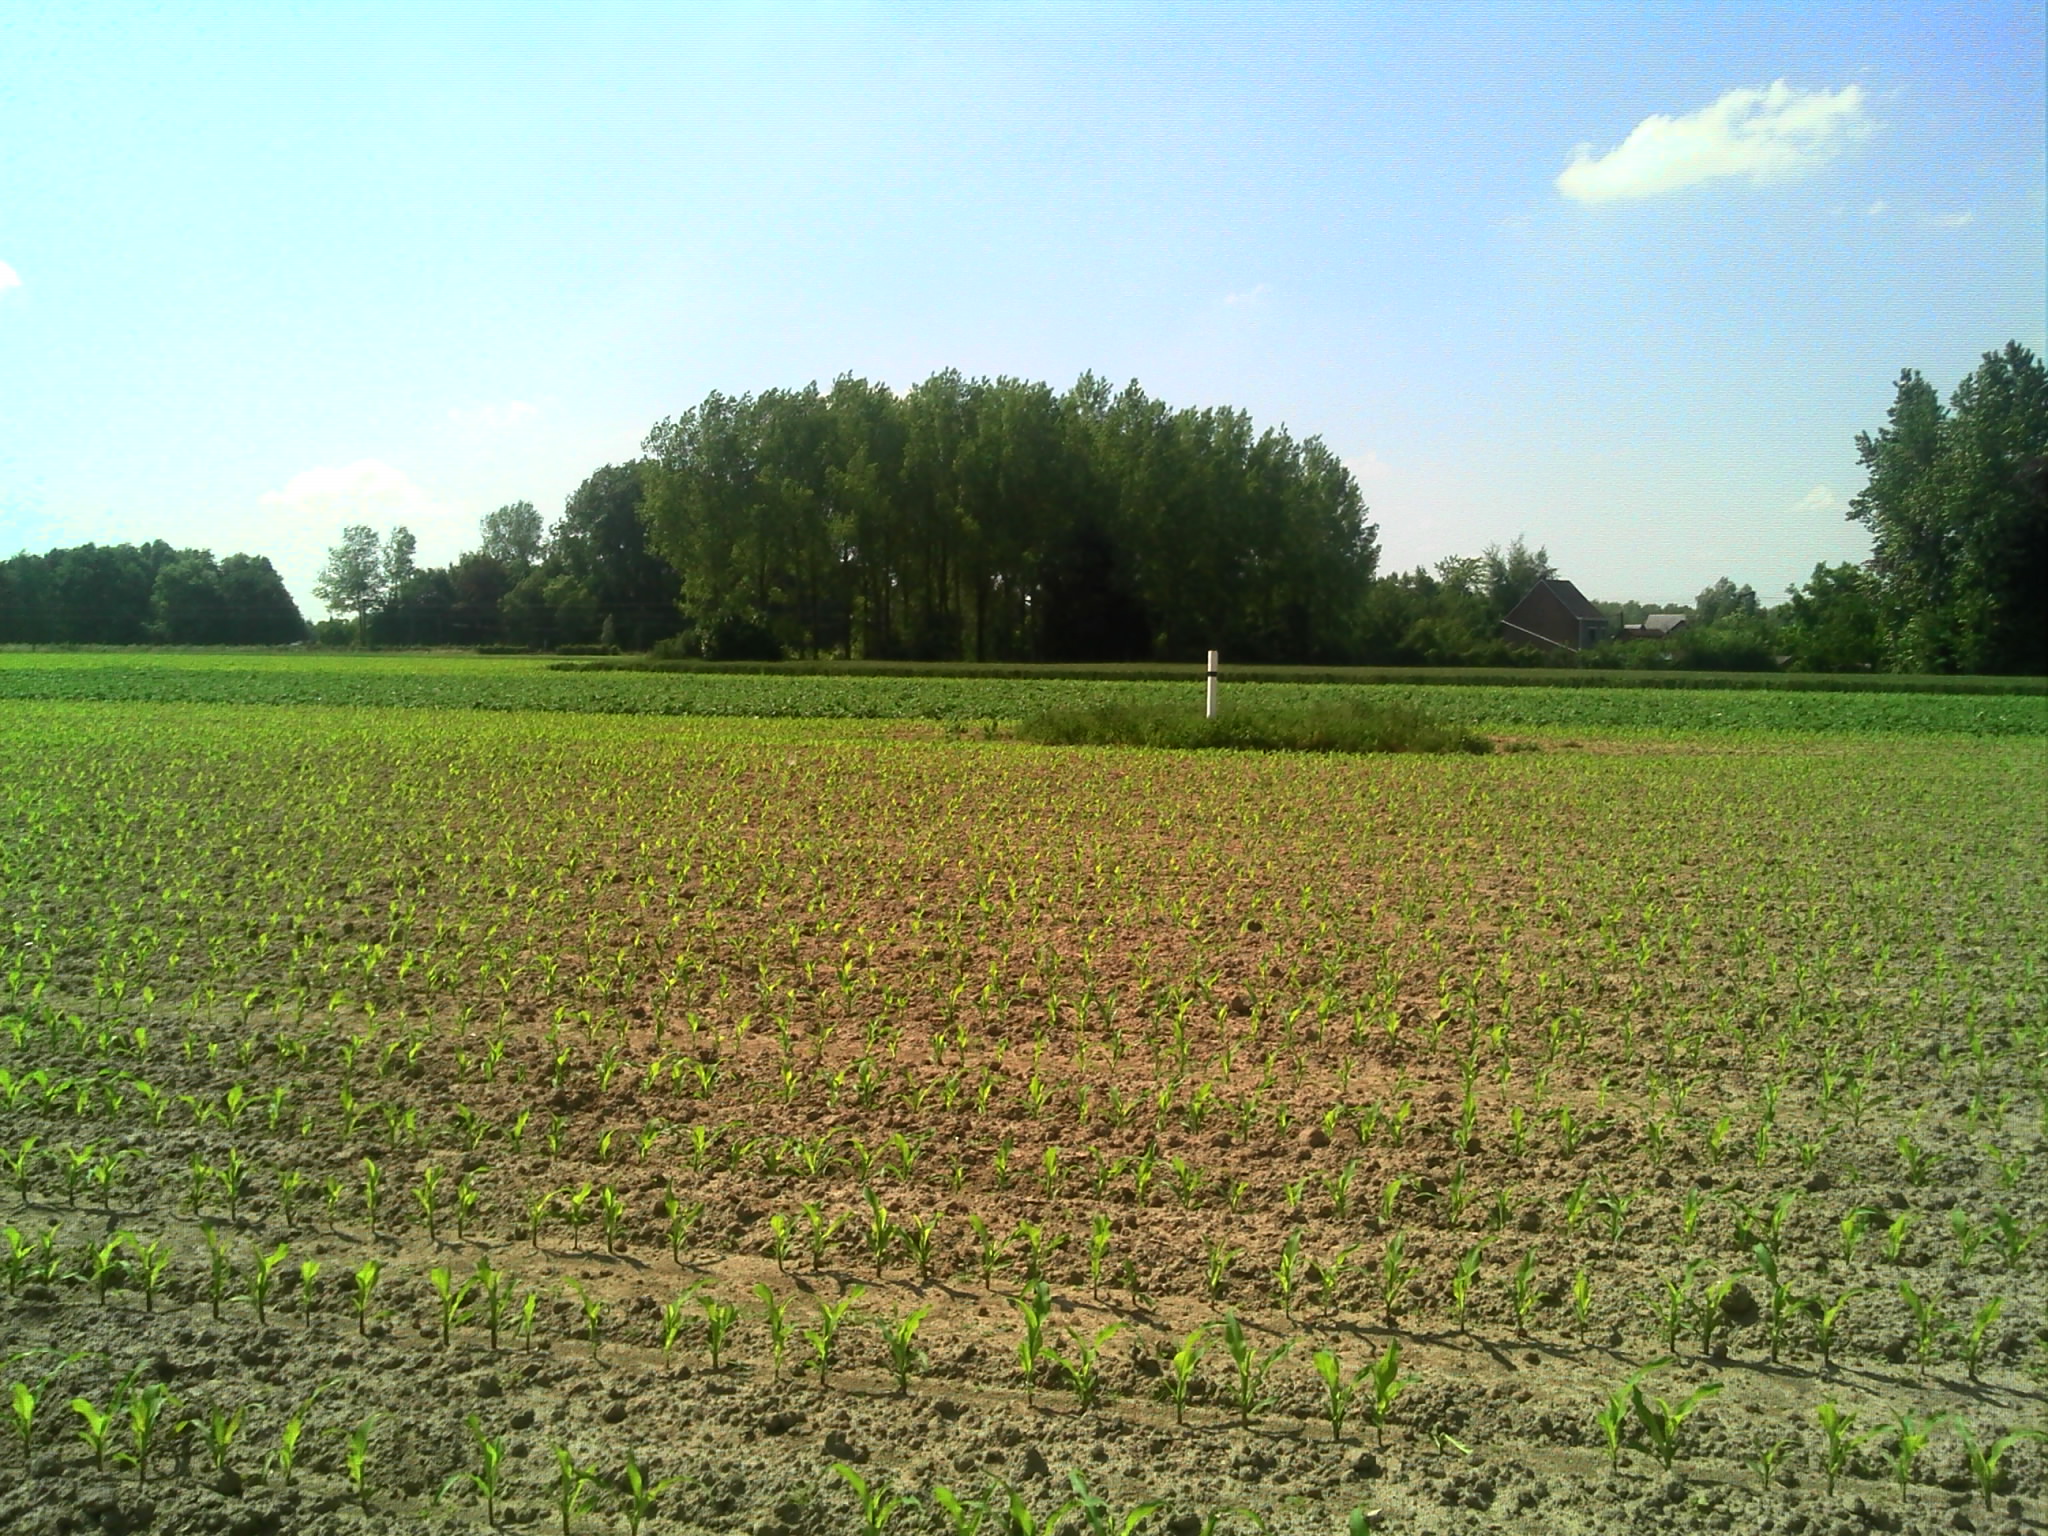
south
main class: Cropland
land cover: Maize
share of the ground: 10 - 25 %
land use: Agriculture (excluding fallow land and kitchen gardens)
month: June
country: BE
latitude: 51.0140
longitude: 4.2792
